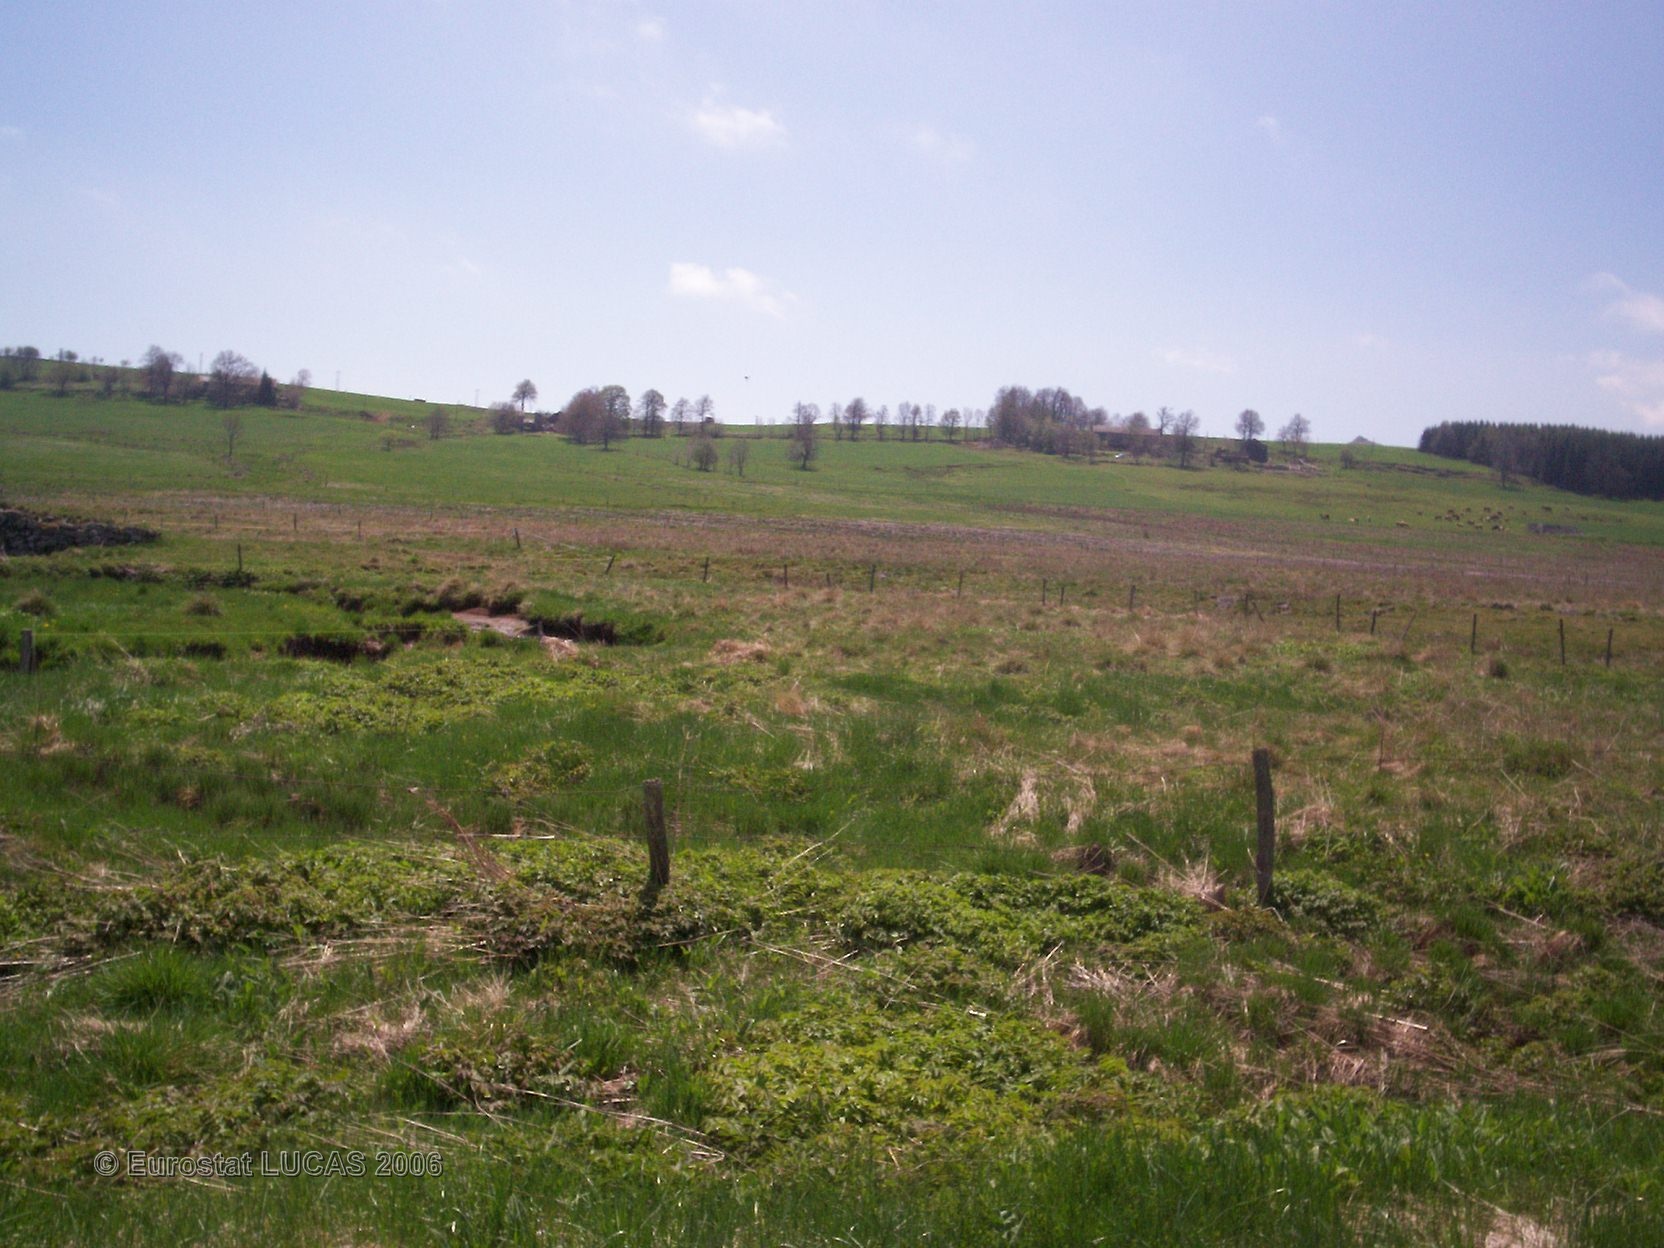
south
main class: Grassland
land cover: Grassland without tree/shrub cover
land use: Agriculture (excluding fallow land and kitchen gardens)
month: May
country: FR
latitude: 45.0200
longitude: 4.2053
